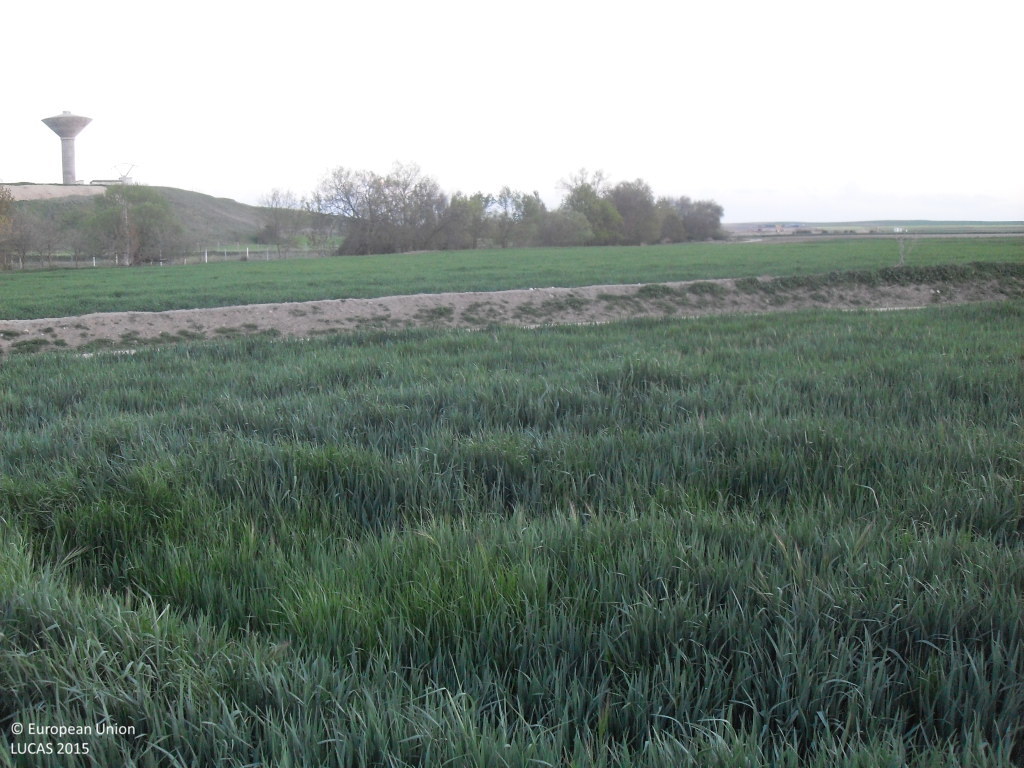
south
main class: Cropland
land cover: Oats
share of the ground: > 75 %
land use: Agriculture (excluding fallow land and kitchen gardens)
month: April
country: ES
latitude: 40.8544
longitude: -5.2155
